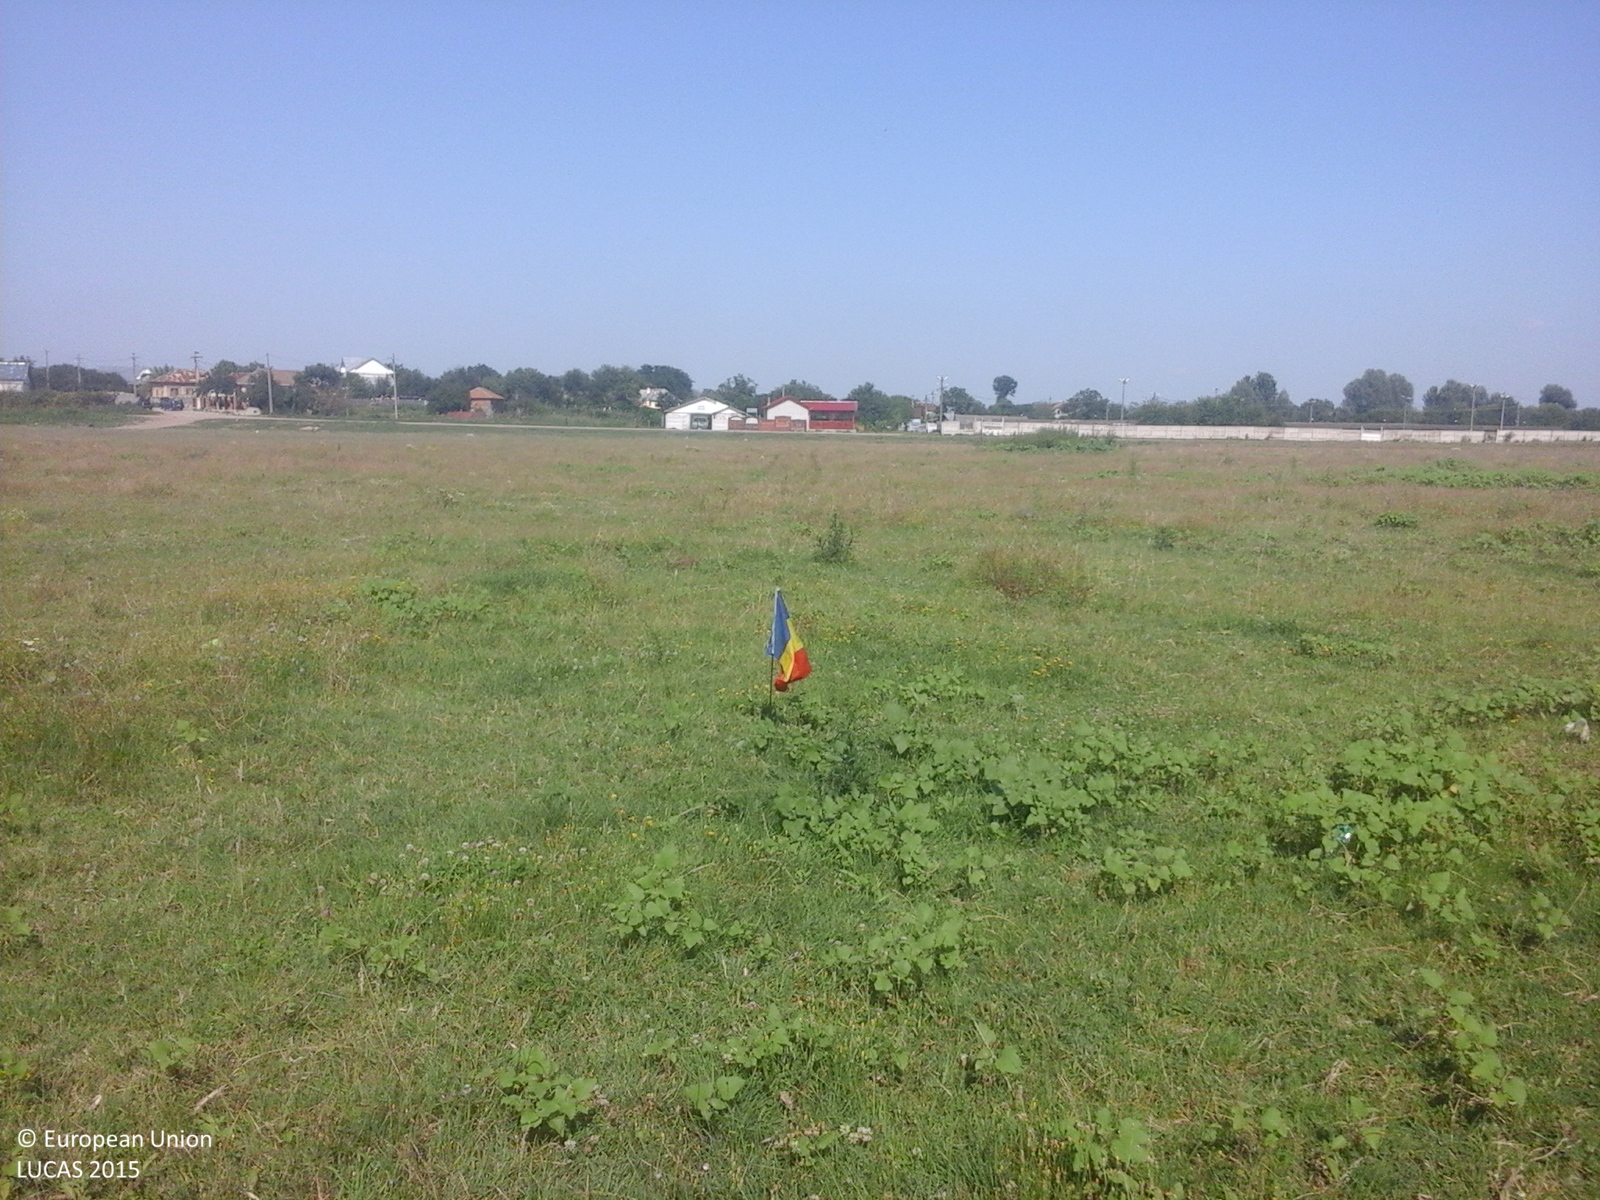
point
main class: Grassland
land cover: Grassland without tree/shrub cover
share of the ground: > 75 %
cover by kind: herbaceous plants 100 %
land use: Agriculture (excluding fallow land and kitchen gardens)
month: July
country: RO
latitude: 44.2500
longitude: 24.3044
